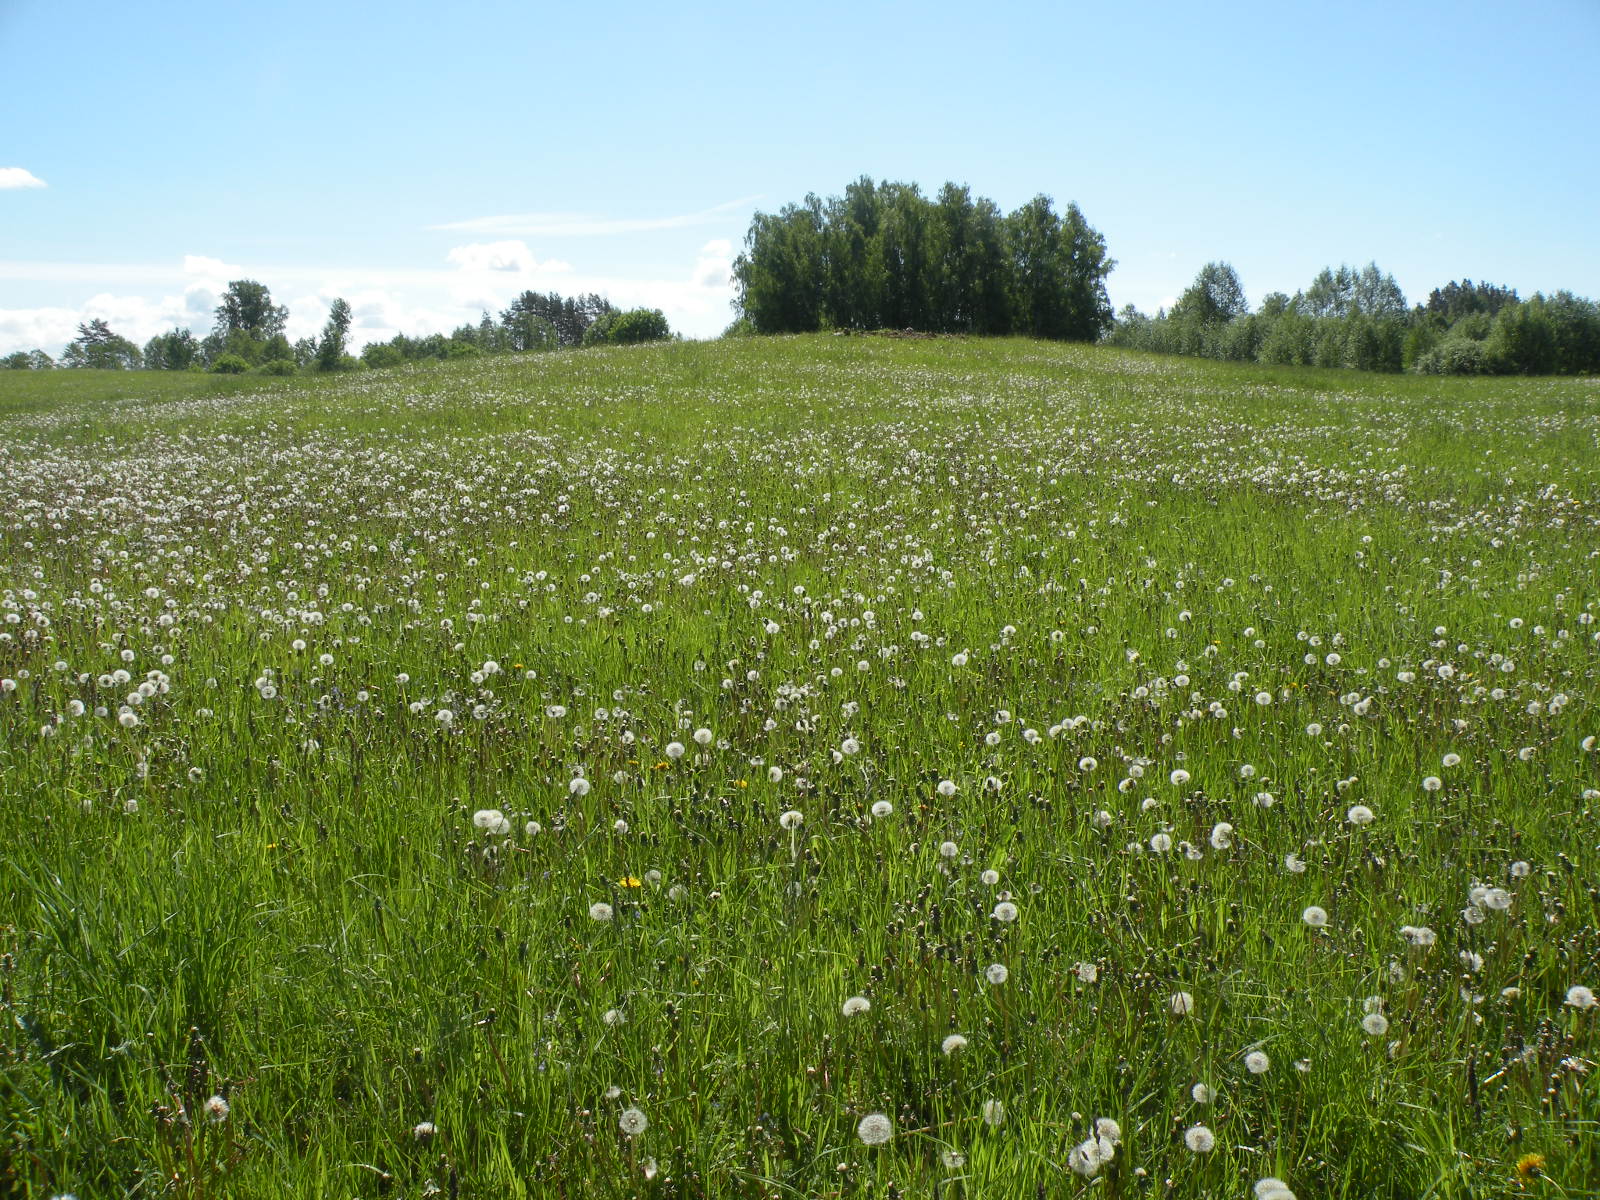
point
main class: Grassland
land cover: Grassland without tree/shrub cover
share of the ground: > 75 %
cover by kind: herbaceous plants 100 %
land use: Agriculture (excluding fallow land and kitchen gardens)
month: May
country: LV
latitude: 56.0474
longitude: 26.2120
